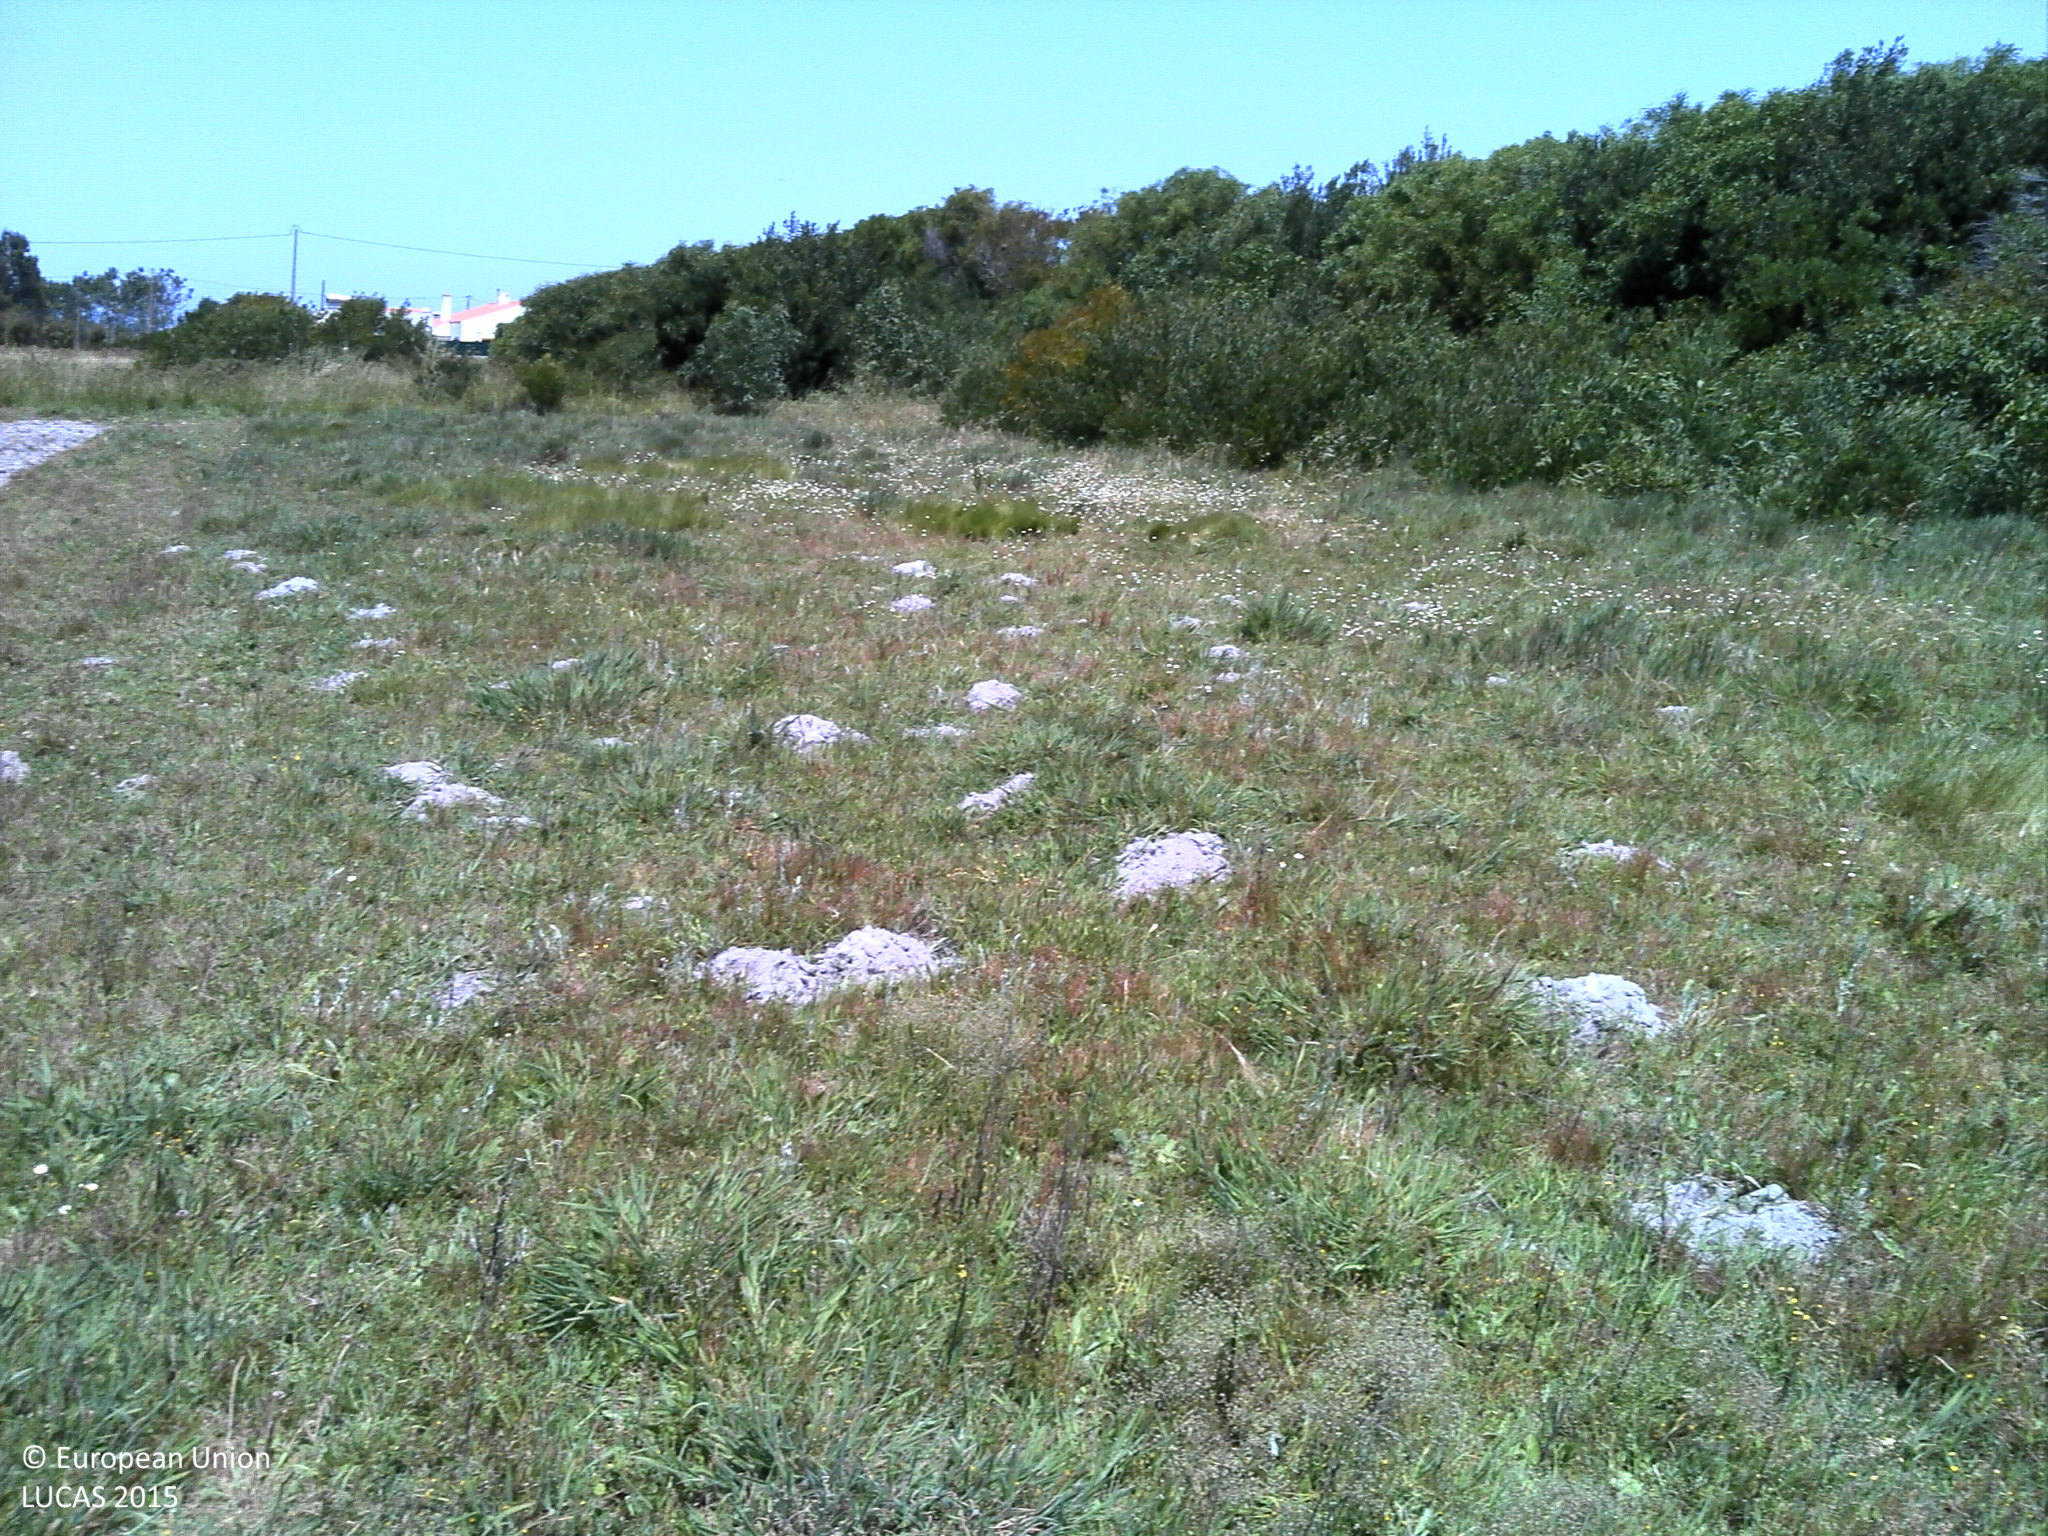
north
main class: Grassland
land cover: Grassland without tree/shrub cover
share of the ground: > 75 %
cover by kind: herbaceous plants 95 %, consolidated bare surface 5 %
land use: Agriculture (excluding fallow land and kitchen gardens)
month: May
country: PT
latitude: 37.5956
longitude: -8.8096
